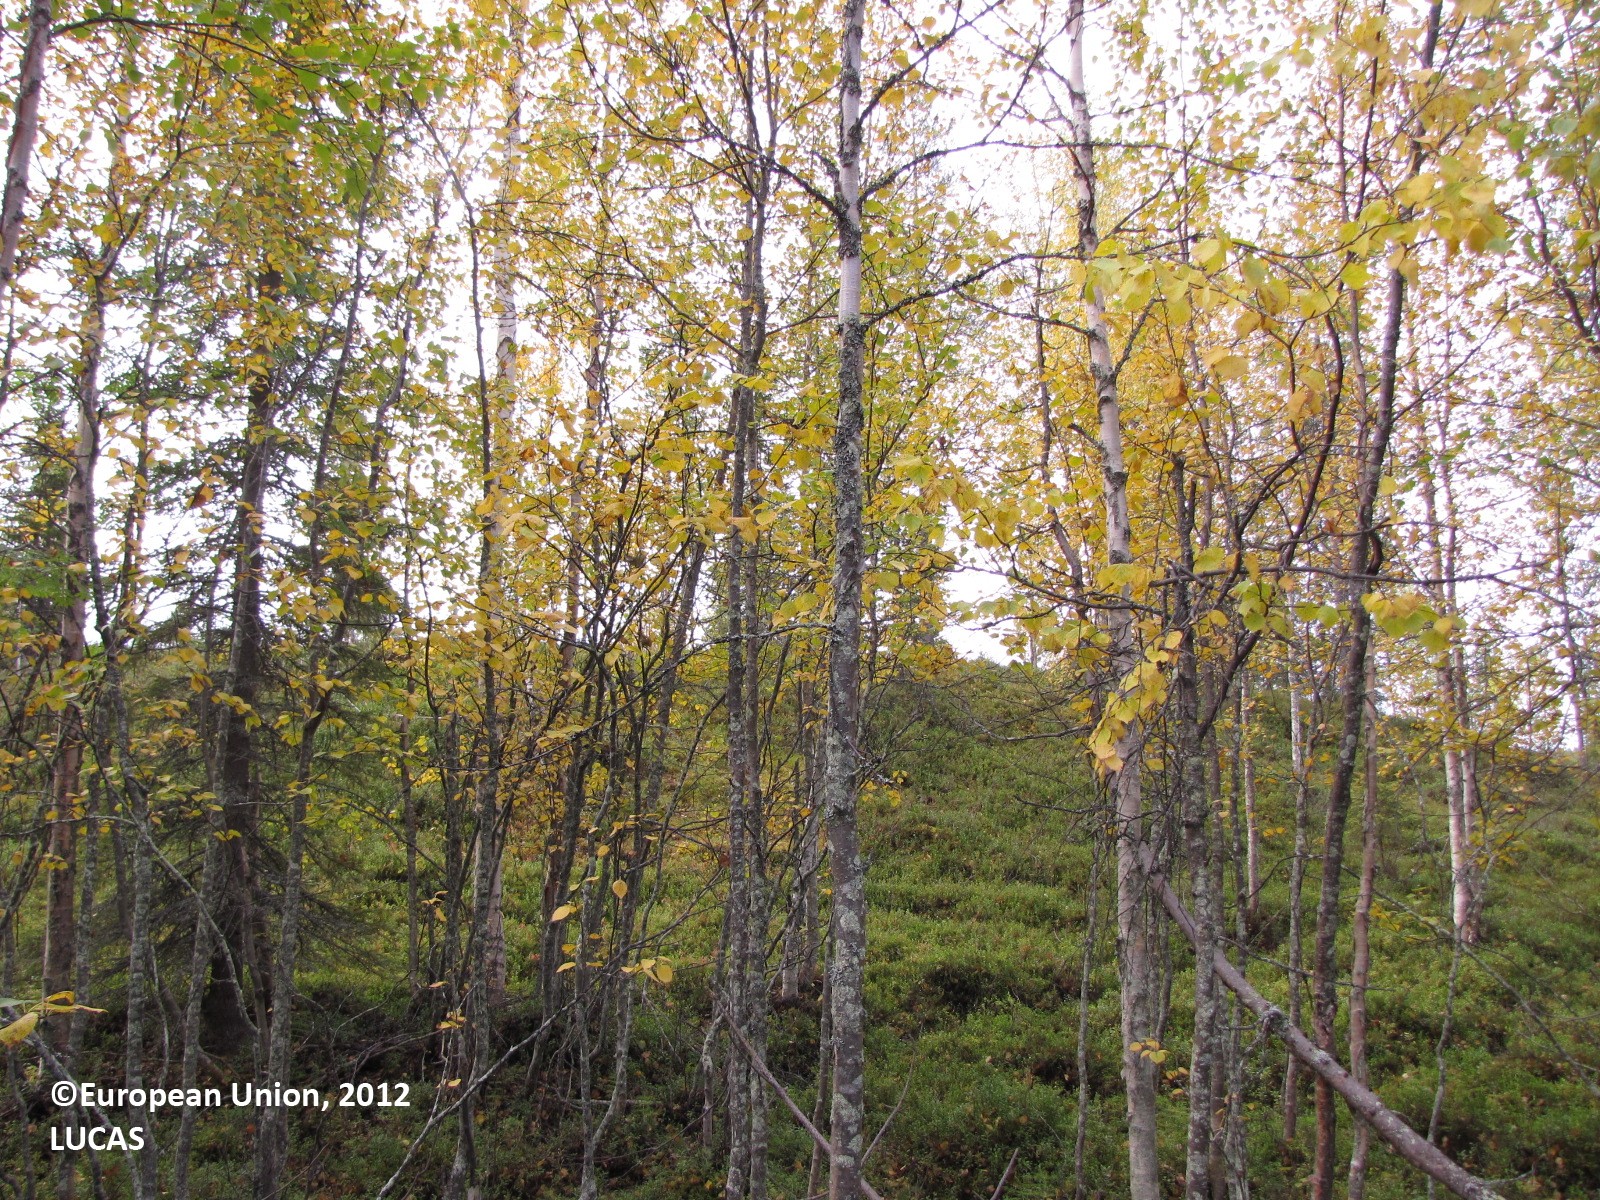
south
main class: Woodland
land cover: Spruce dominated mixed woodland
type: boreal forest
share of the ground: 25 - 50 %
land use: Forestry
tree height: > 5 m
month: September
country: FI
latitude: 67.3608
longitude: 25.2006
